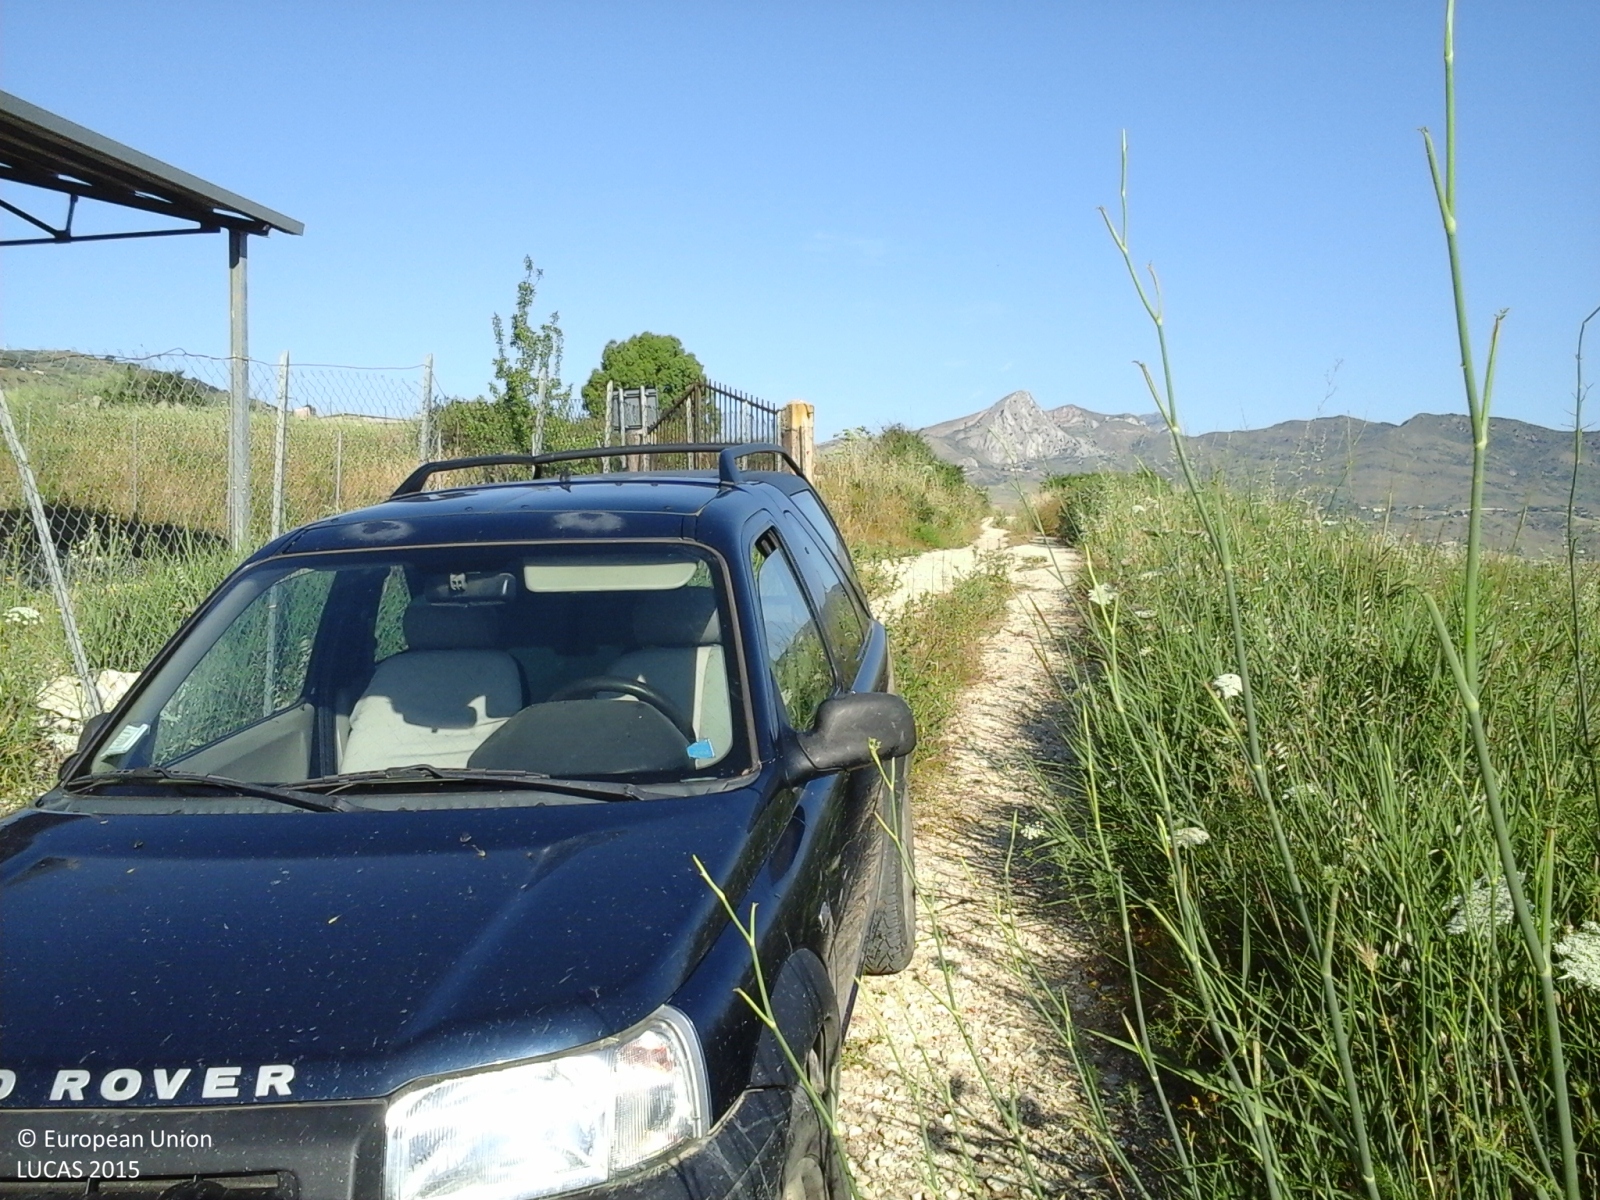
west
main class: Grassland
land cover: Grassland with sparse tree/shrub cover
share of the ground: > 75 %
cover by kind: herbaceous plants 85 %, shrubs 10 %, broadleaved forest trees 5 %
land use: Agriculture (excluding fallow land and kitchen gardens)
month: June
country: IT
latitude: 37.8282
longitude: 13.5080
